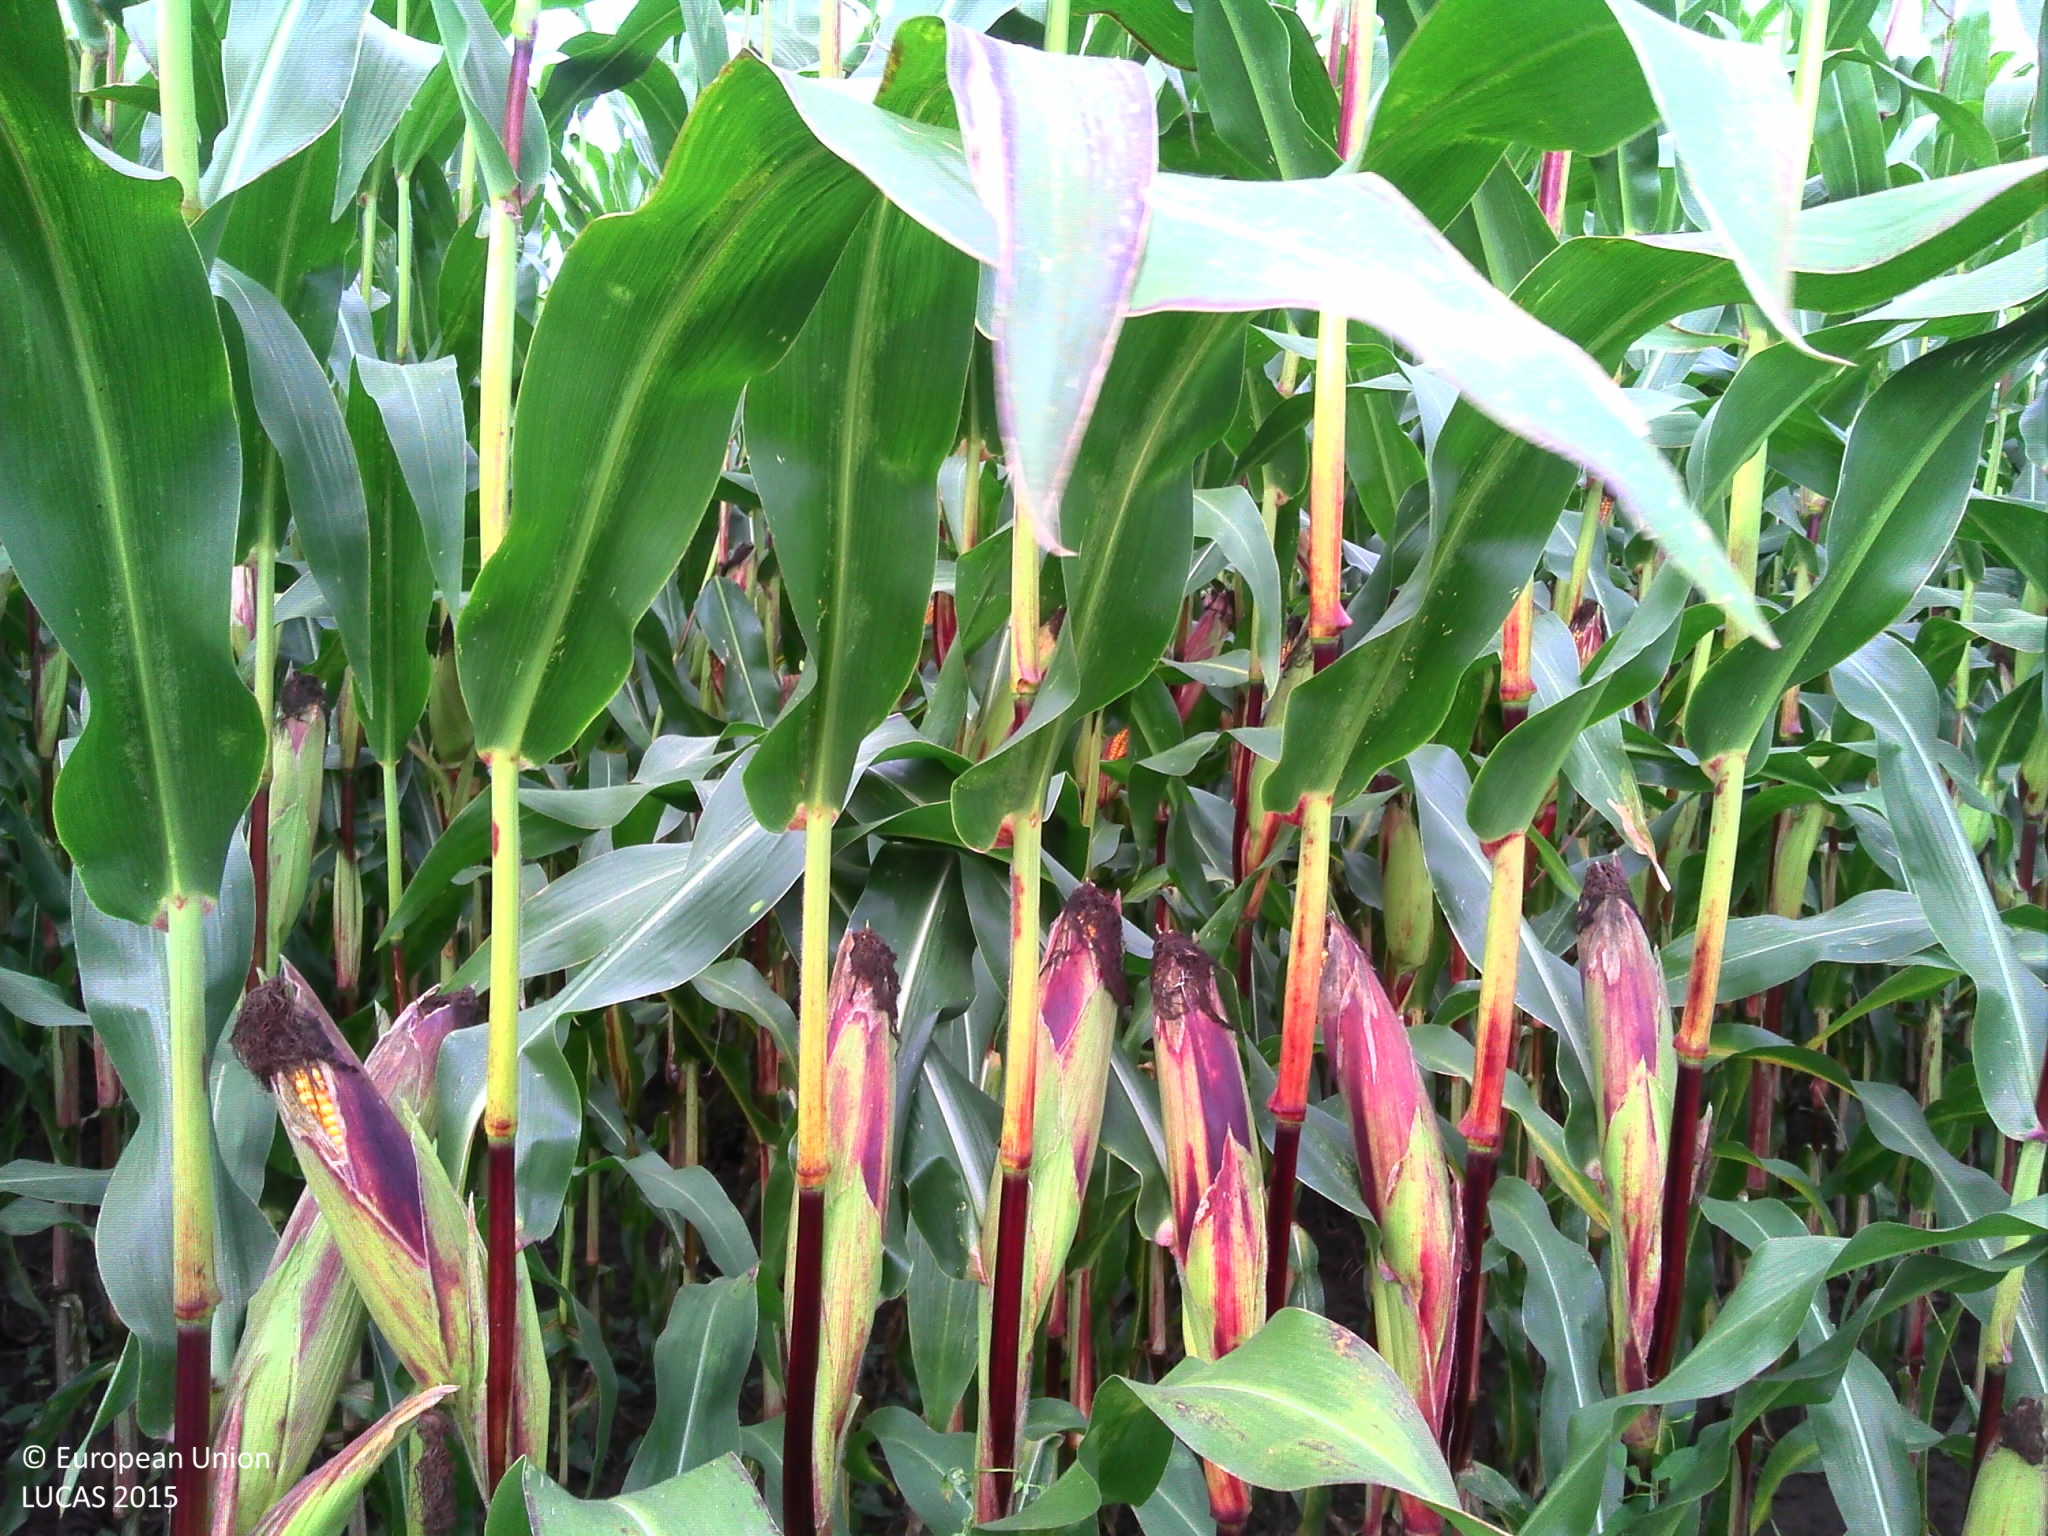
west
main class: Cropland
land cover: Maize
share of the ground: > 75 %
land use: Agriculture (excluding fallow land and kitchen gardens)
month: September
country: BE
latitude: 51.1271
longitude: 4.3799
